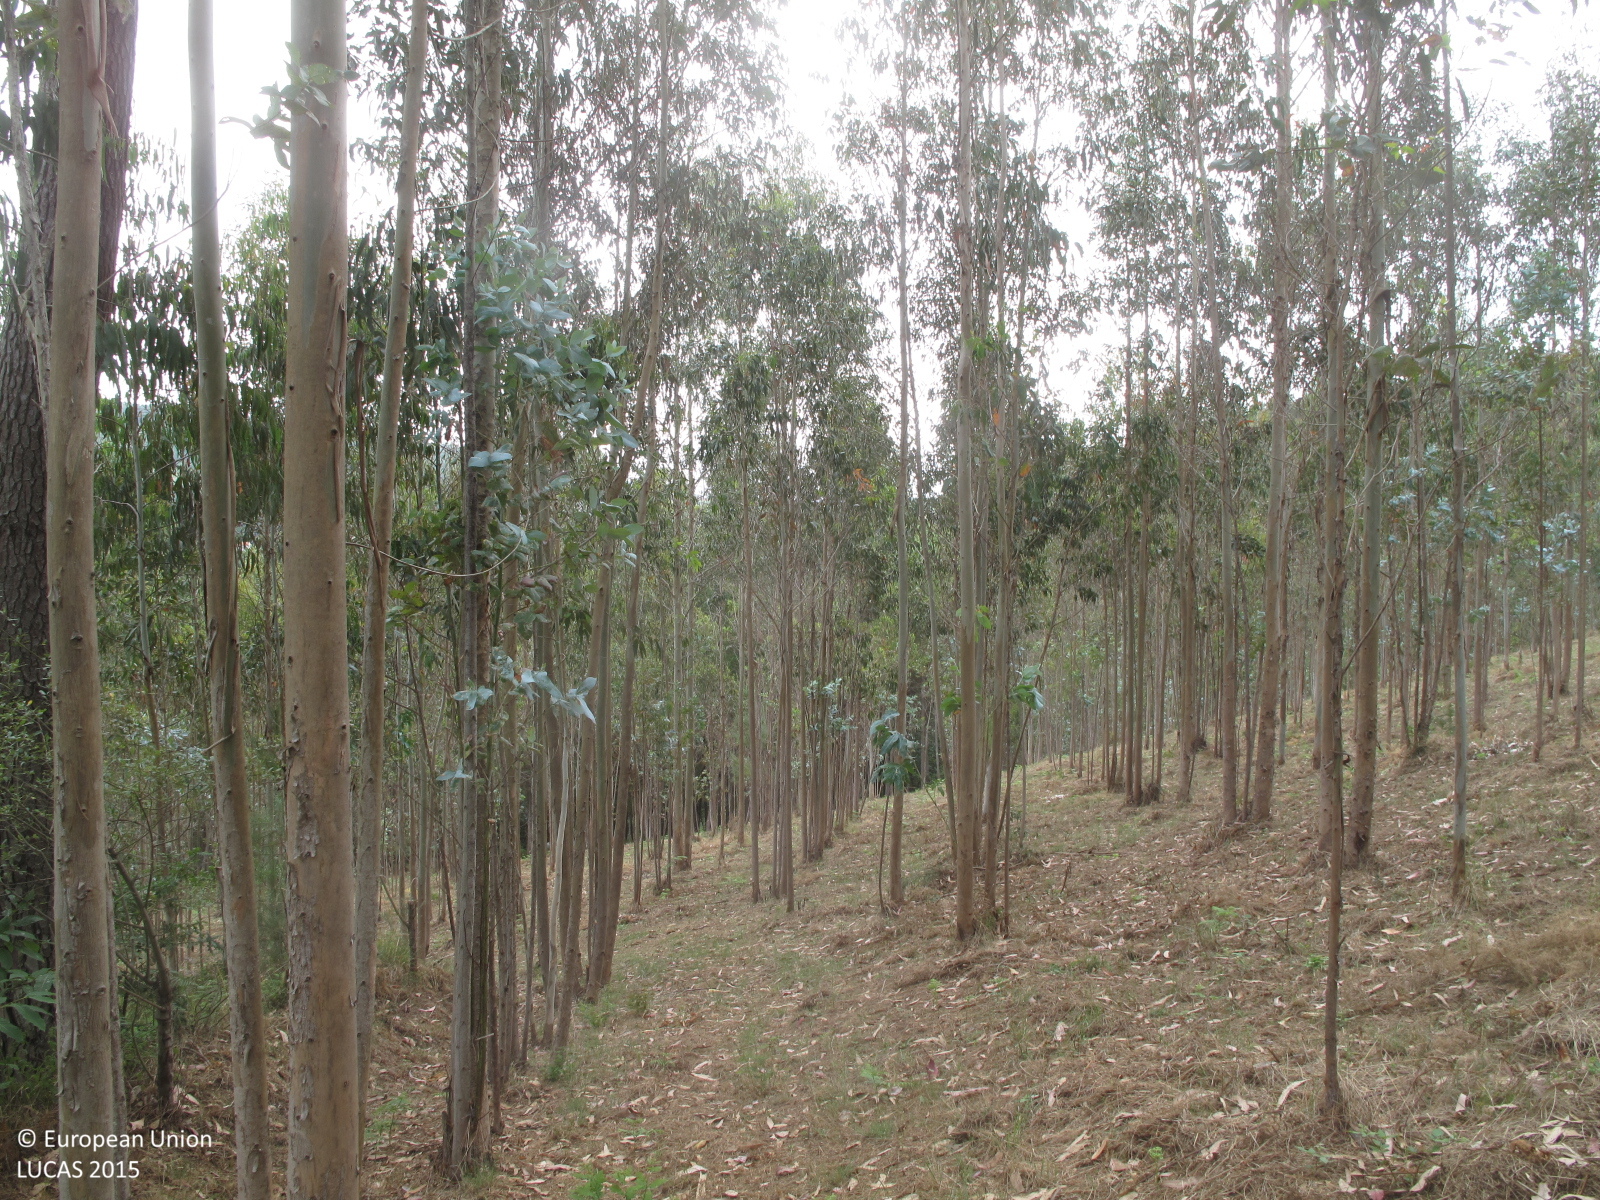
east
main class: Woodland
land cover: Broadleaved woodland
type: exotic forest
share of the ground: 25 - 50 %
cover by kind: herbaceous plants 50 %, broadleaved forest trees 40 %, shrubs 10 %
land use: Forestry
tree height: > 5 m
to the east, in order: Broadleaved woodland; Pine dominated coniferous woodland; Broadleaved woodland; Tracks; Broadleaved woodland; Rivers and streams; Broadleaved woodland
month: July
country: ES
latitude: 43.2727
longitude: -8.6318
